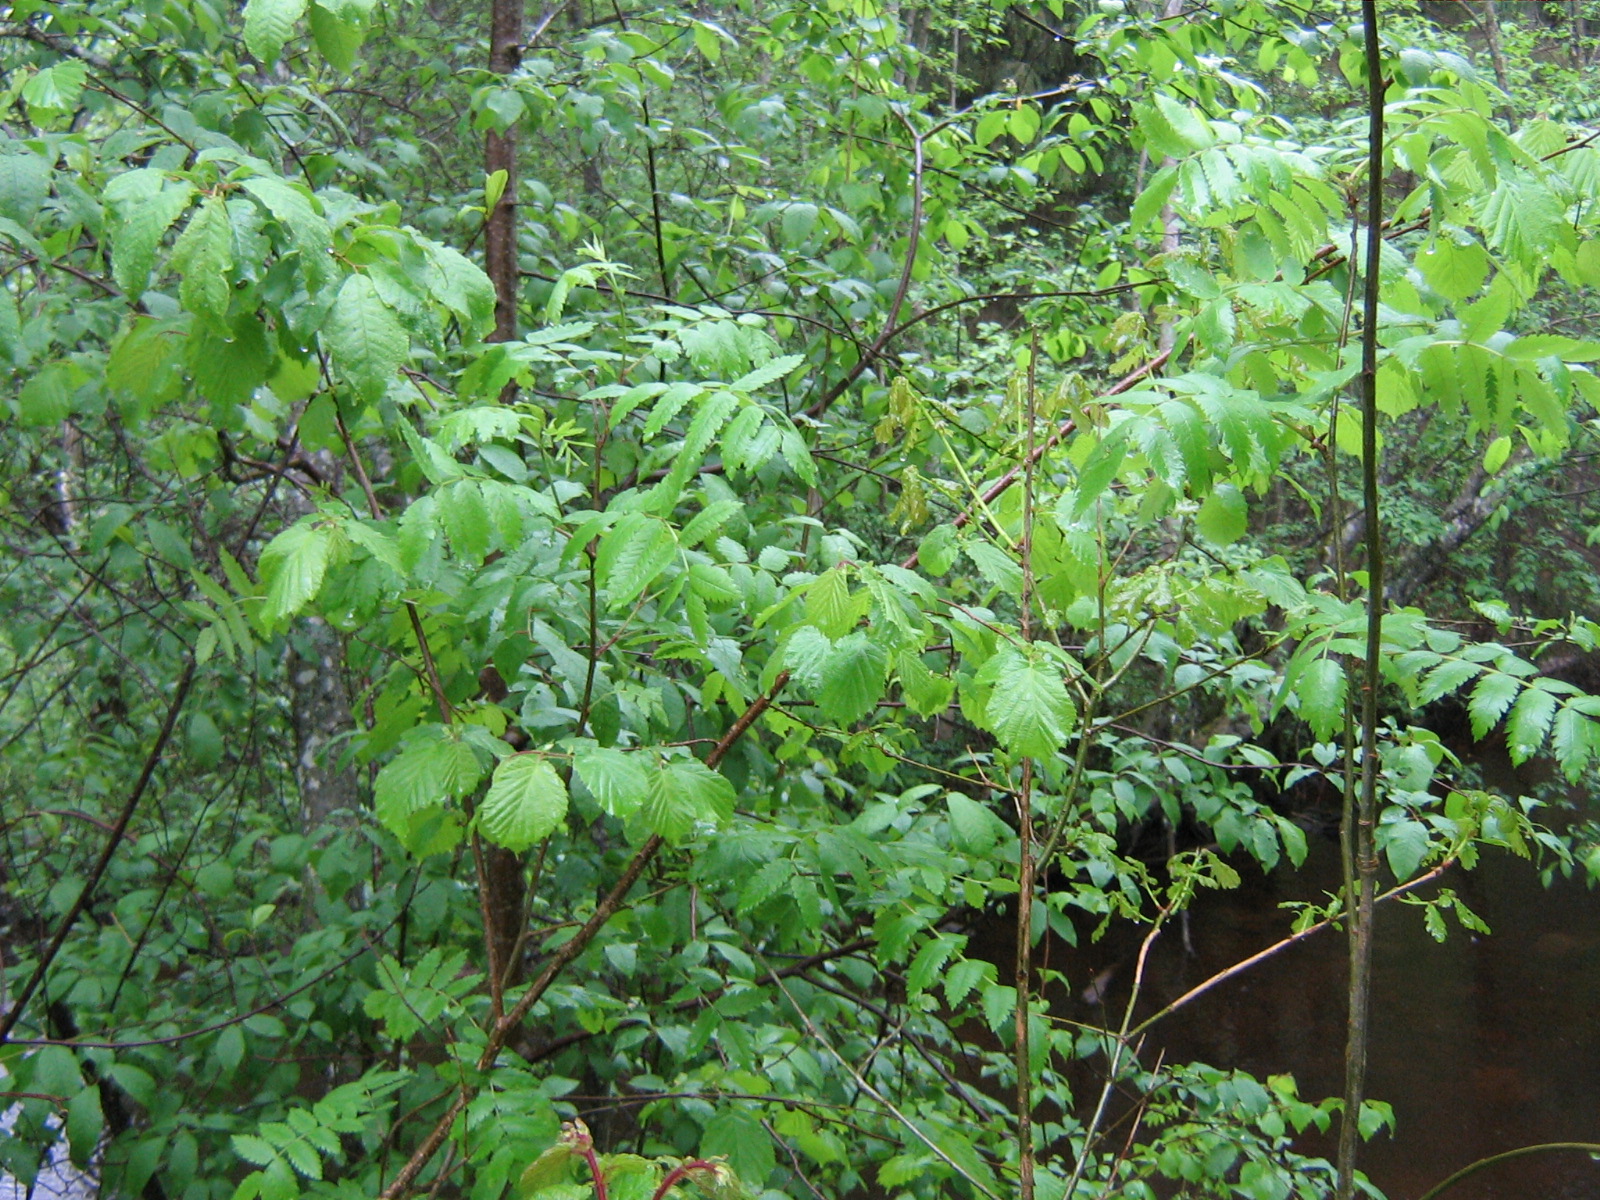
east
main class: Woodland
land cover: Broadleaved woodland
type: non-riverine alder, birch or aspen forest
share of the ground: > 75 %
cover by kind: broadleaved forest trees 100 %
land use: Semi-natural and natural areas not in use
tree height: > 5 m
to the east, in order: Broadleaved woodland; Inland fresh running water; Broadleaved woodland; Other mixed woodland; Ditches and canals; Abandoned hedges; Grass margins; Paved roads, cycling and walking lanes; Grass margins; Ditches and canals; Abandoned hedges; Other mixed woodland; Grassland with sparse tree/shrub cover
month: May
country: LV
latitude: 57.3380
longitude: 25.8927
